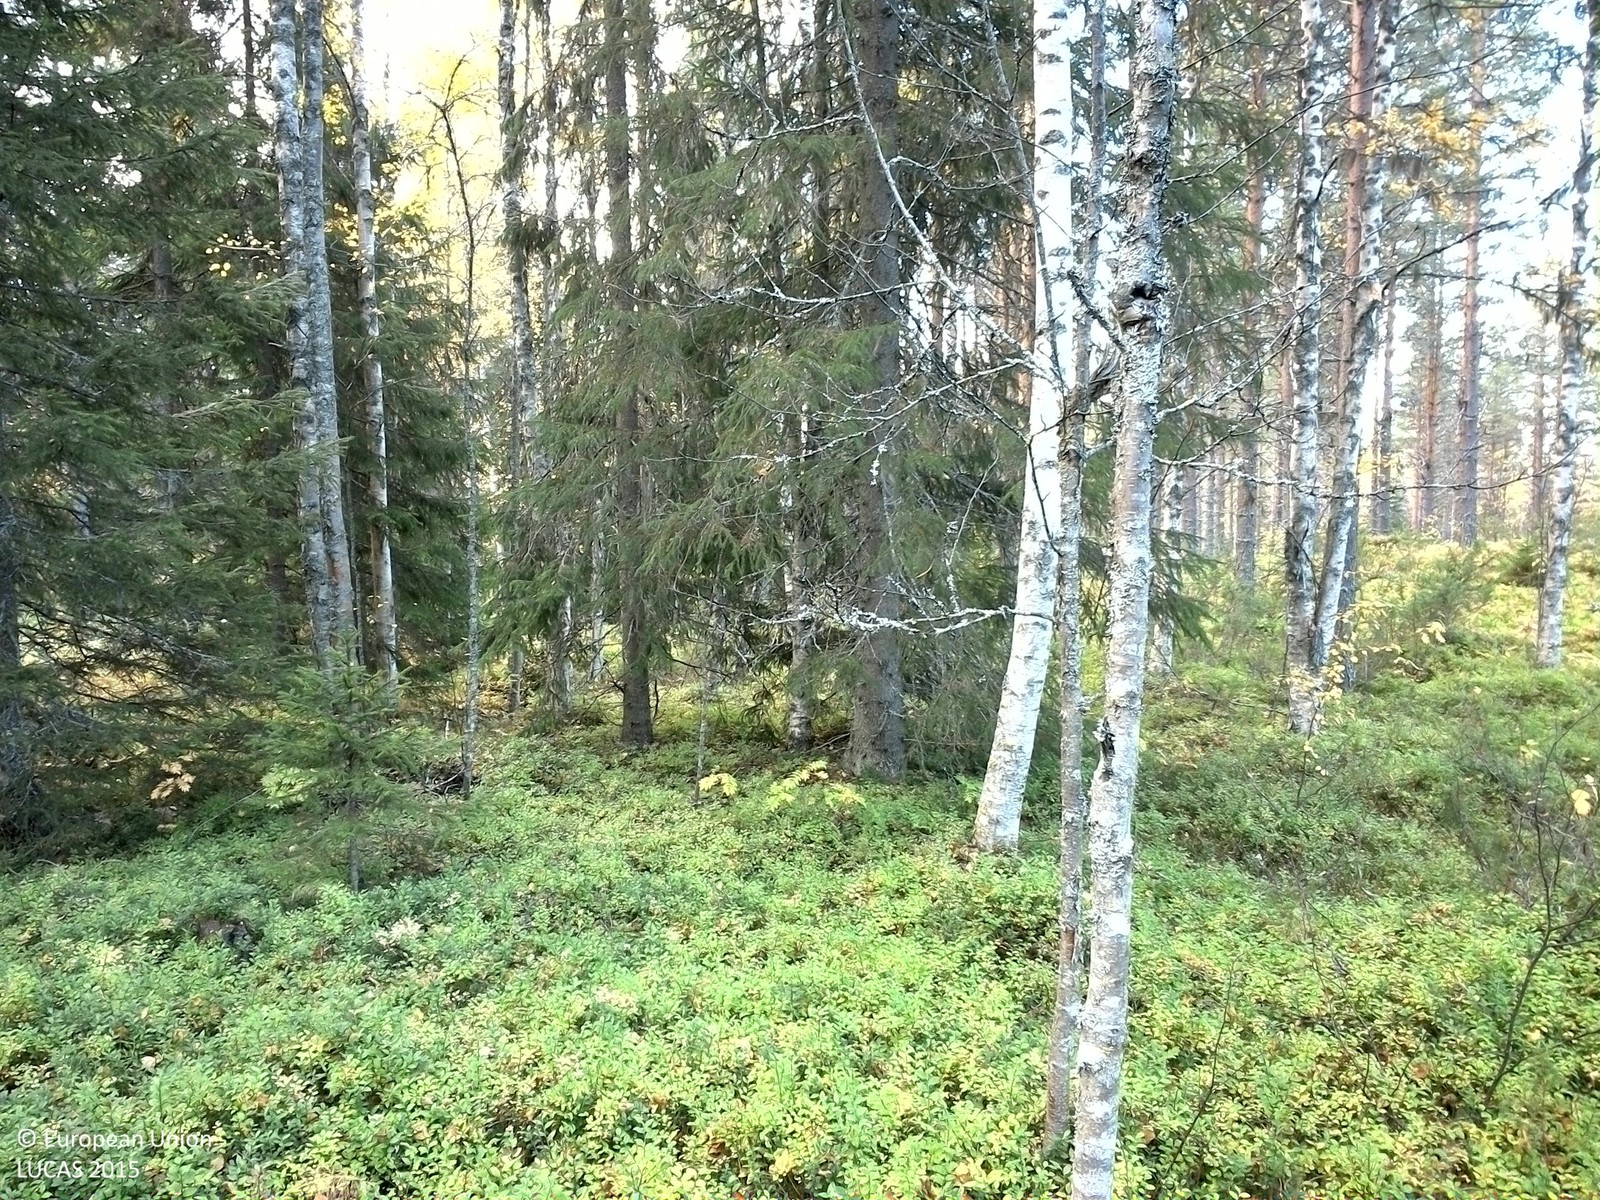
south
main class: Woodland
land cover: Other mixed woodland
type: boreal forest
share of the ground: 50 - 75 %
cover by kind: coniferous forest trees 35 %, shrubs 30 %, broadleaved forest trees 20 %, lichens and mosses 10 %, herbaceous plants 5 %
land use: Forestry
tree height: > 5 m
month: September
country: SE
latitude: 64.2172
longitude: 16.3370
